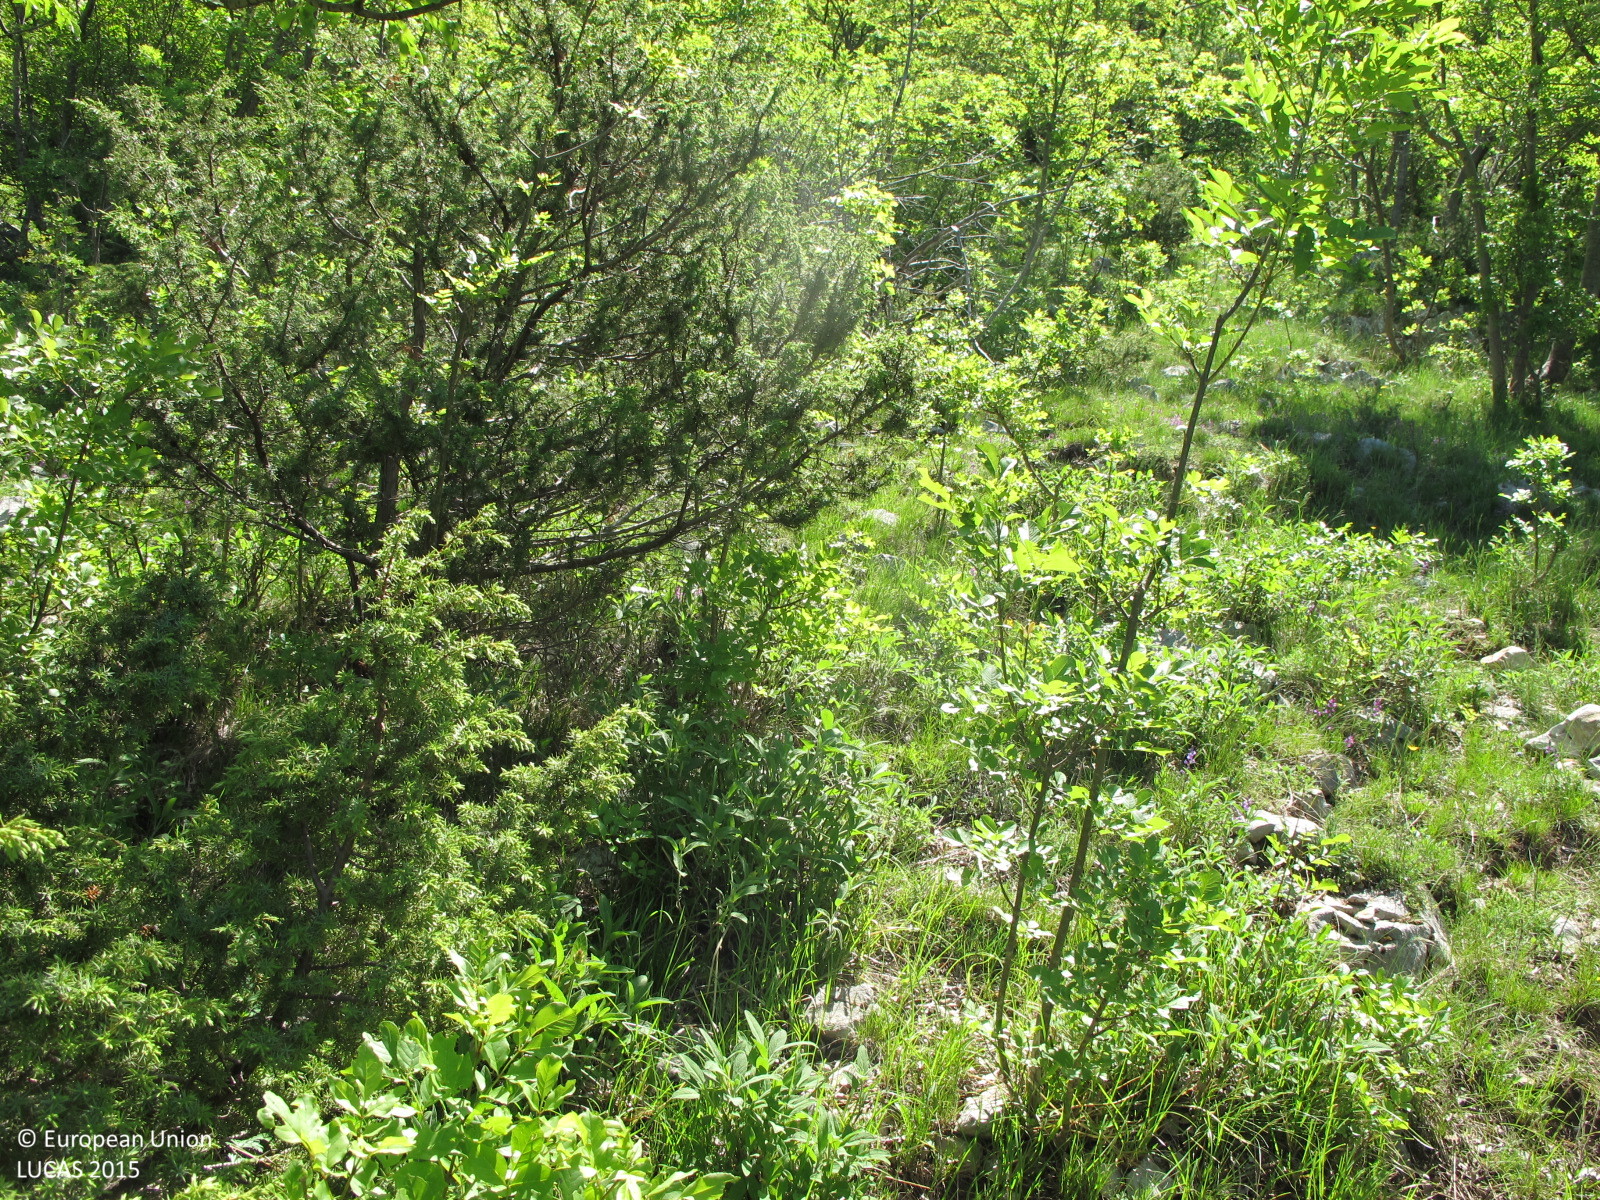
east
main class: Woodland
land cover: Broadleaved woodland
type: mesophytic deciduous forest
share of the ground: > 75 %
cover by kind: broadleaved forest trees 70 %, coniferous forest trees 10 %, shrubs 10 %, herbaceous plants 5 %, consolidated bare surface 5 %
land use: Forestry
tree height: < 5 m
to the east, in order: Broadleaved woodland; Grassland without tree/shrub cover
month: May
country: HR
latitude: 45.1587
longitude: 14.8414
